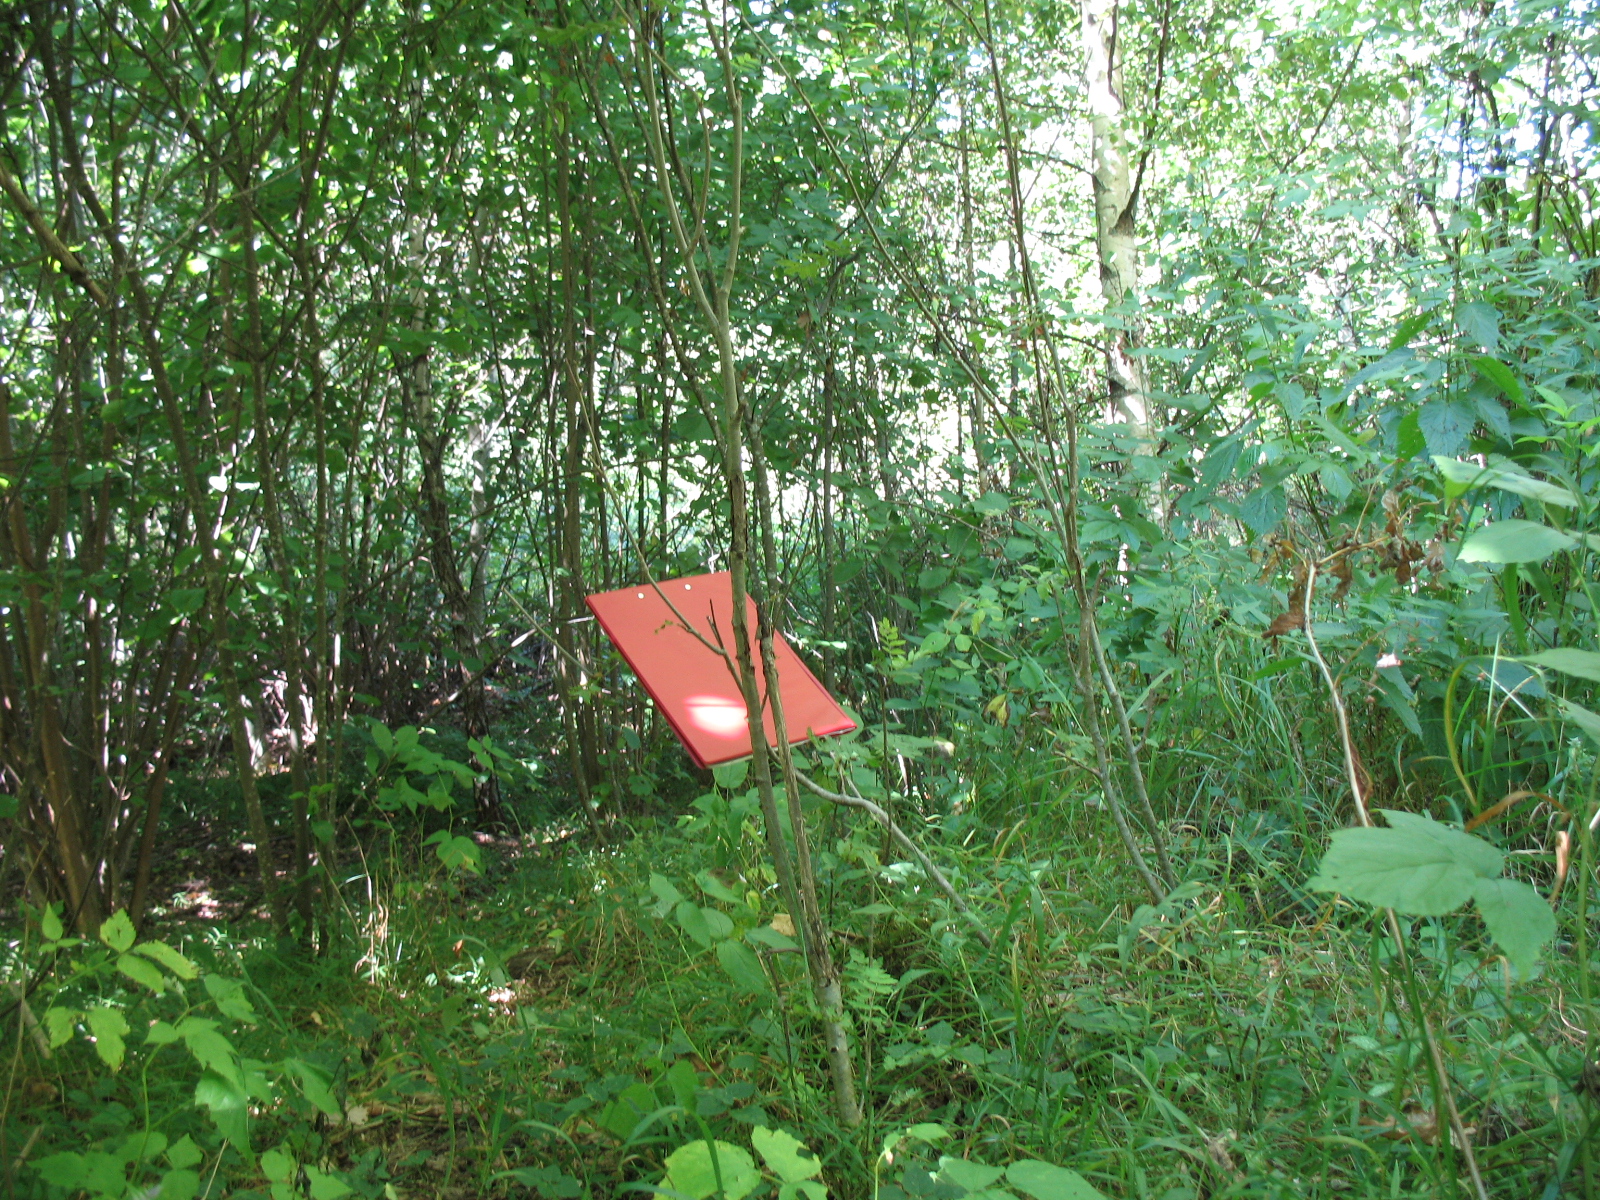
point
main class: Woodland
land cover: Broadleaved woodland
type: non-riverine alder, birch or aspen forest
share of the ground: 50 - 75 %
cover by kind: broadleaved forest trees 70 %, herbaceous plants 25 %, shrubs 5 %
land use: Forestry
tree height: > 5 m
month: August
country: LV
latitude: 56.5362
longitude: 25.6865
